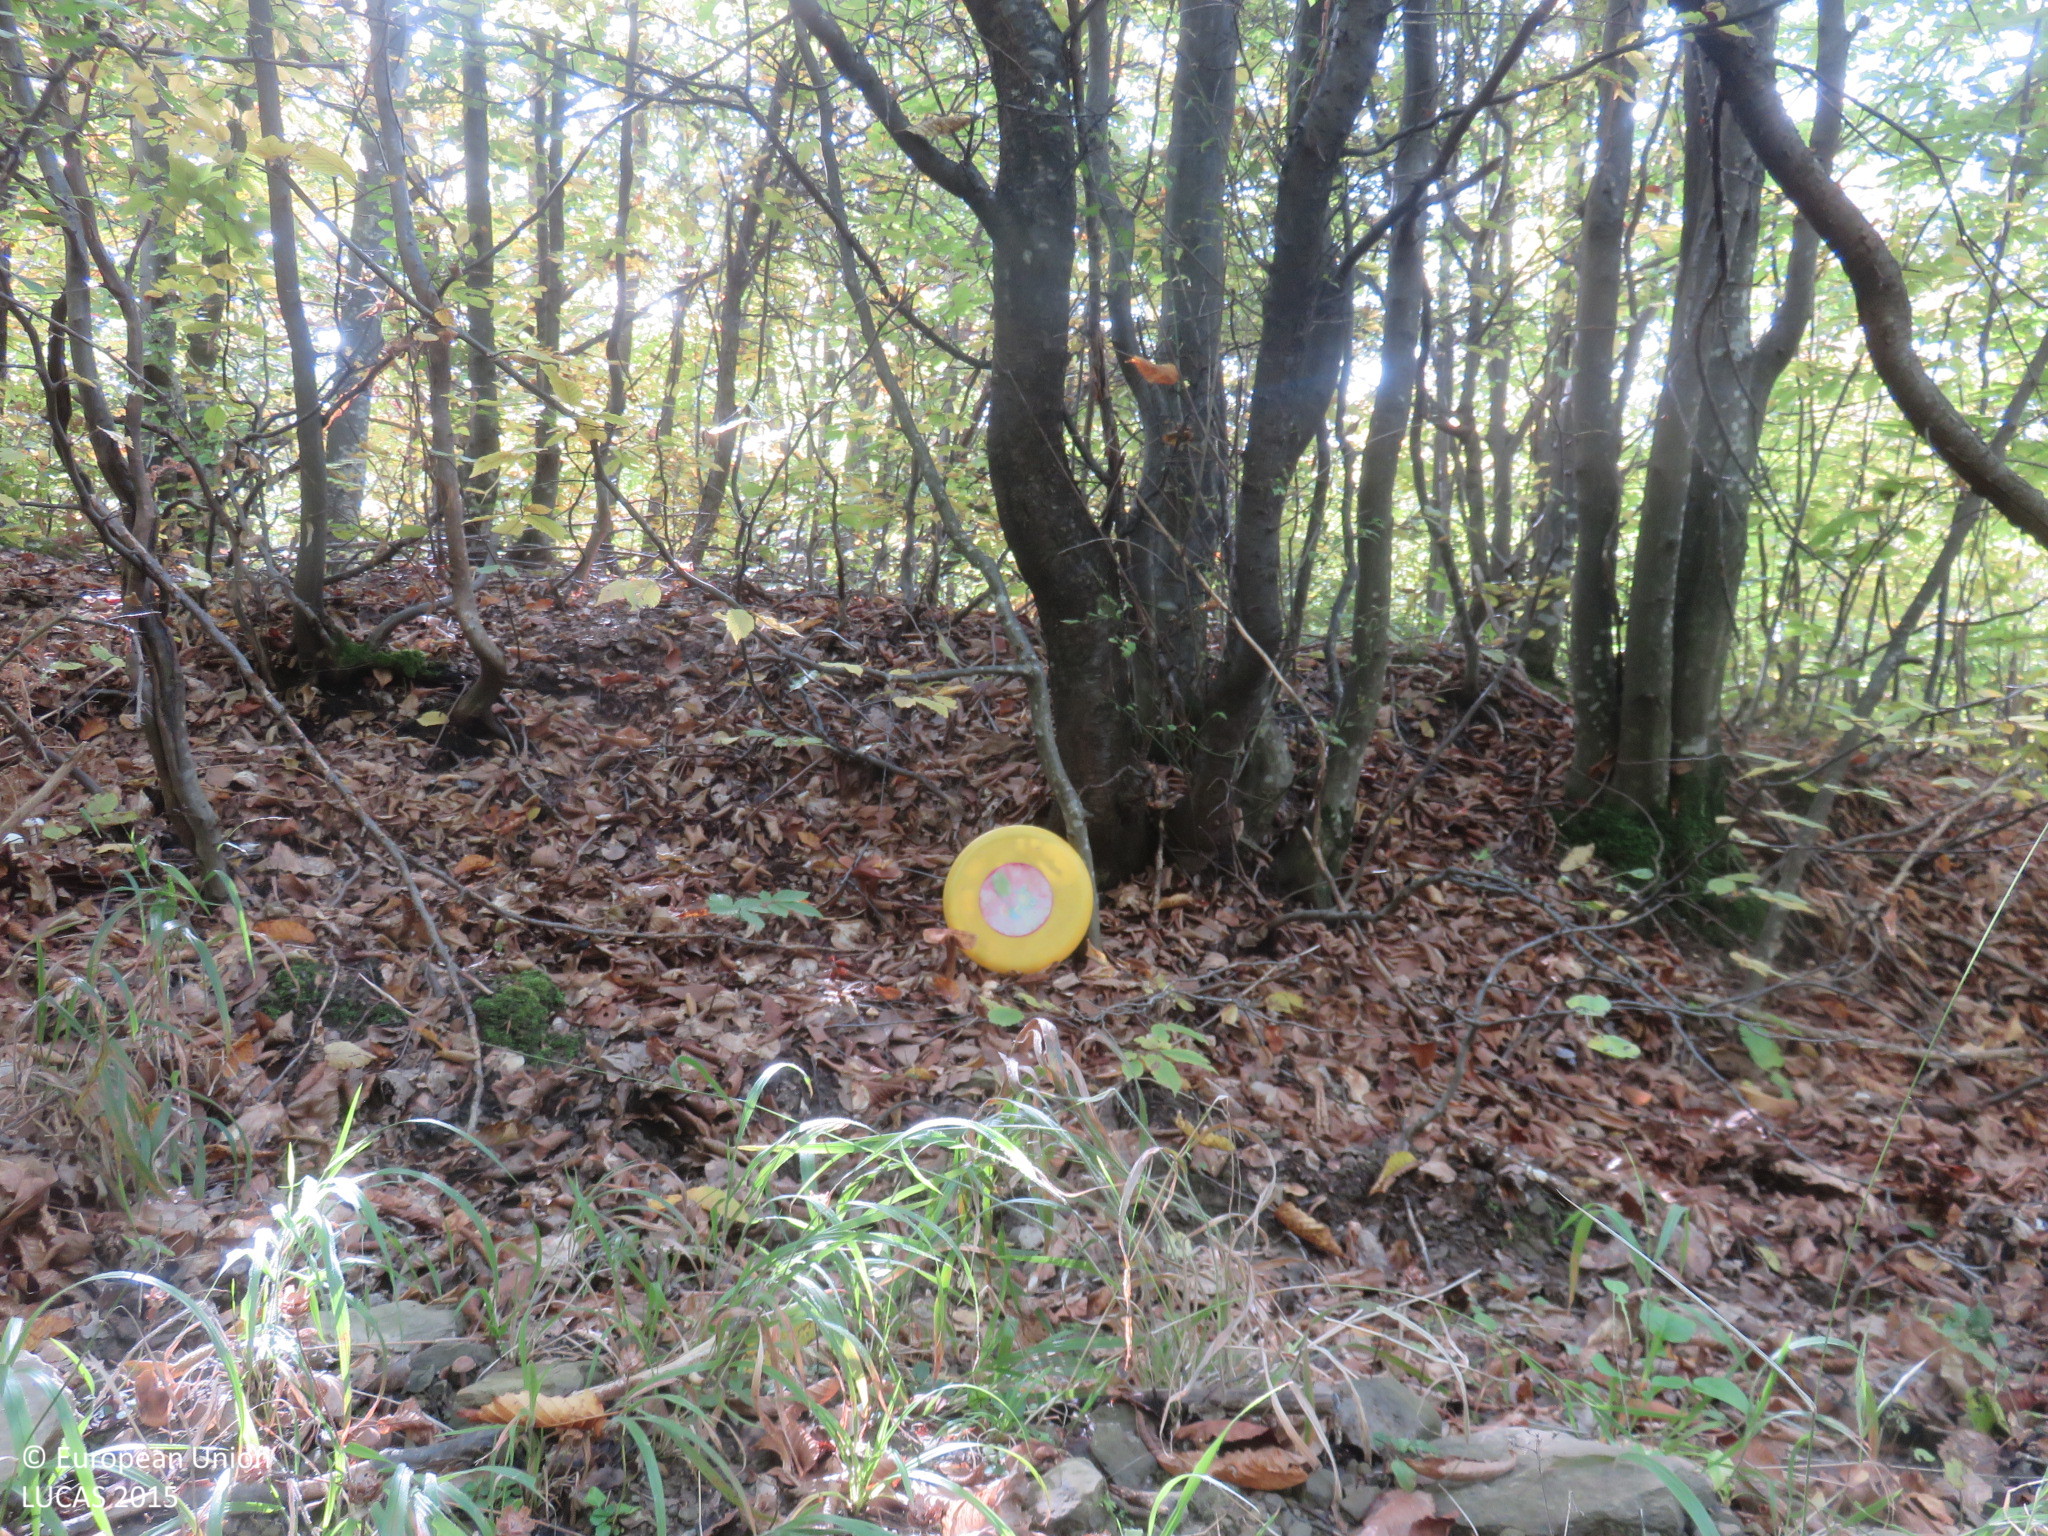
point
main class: Woodland
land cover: Broadleaved woodland
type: beech forest
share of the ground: > 75 %
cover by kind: broadleaved forest trees 95 %, shrubs 5 %
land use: Forestry
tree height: > 5 m
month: October
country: BG
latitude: 42.7855
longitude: 24.9393
